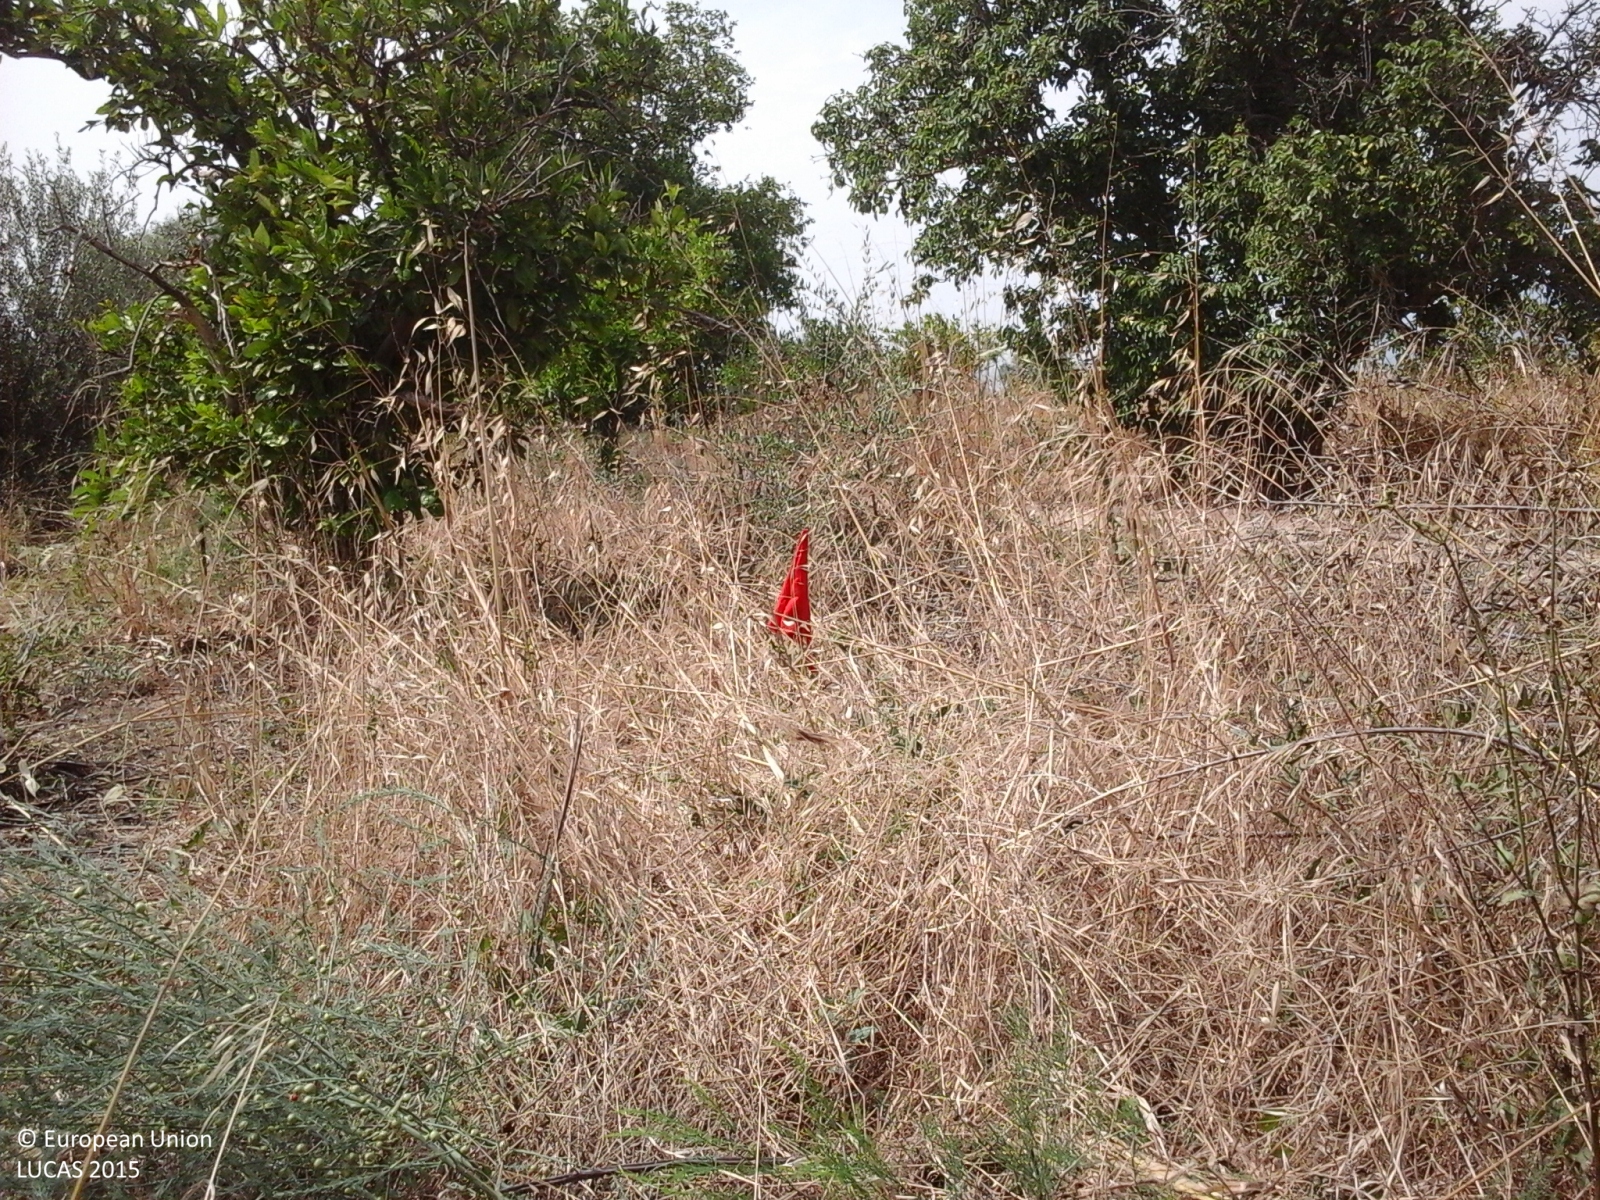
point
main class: Cropland
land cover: Oranges
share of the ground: 50 - 75 %
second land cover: Spontaneously vegetated surfaces
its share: > 75 %
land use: Abandoned areas
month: June
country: IT
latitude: 37.4947
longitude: 14.8848
